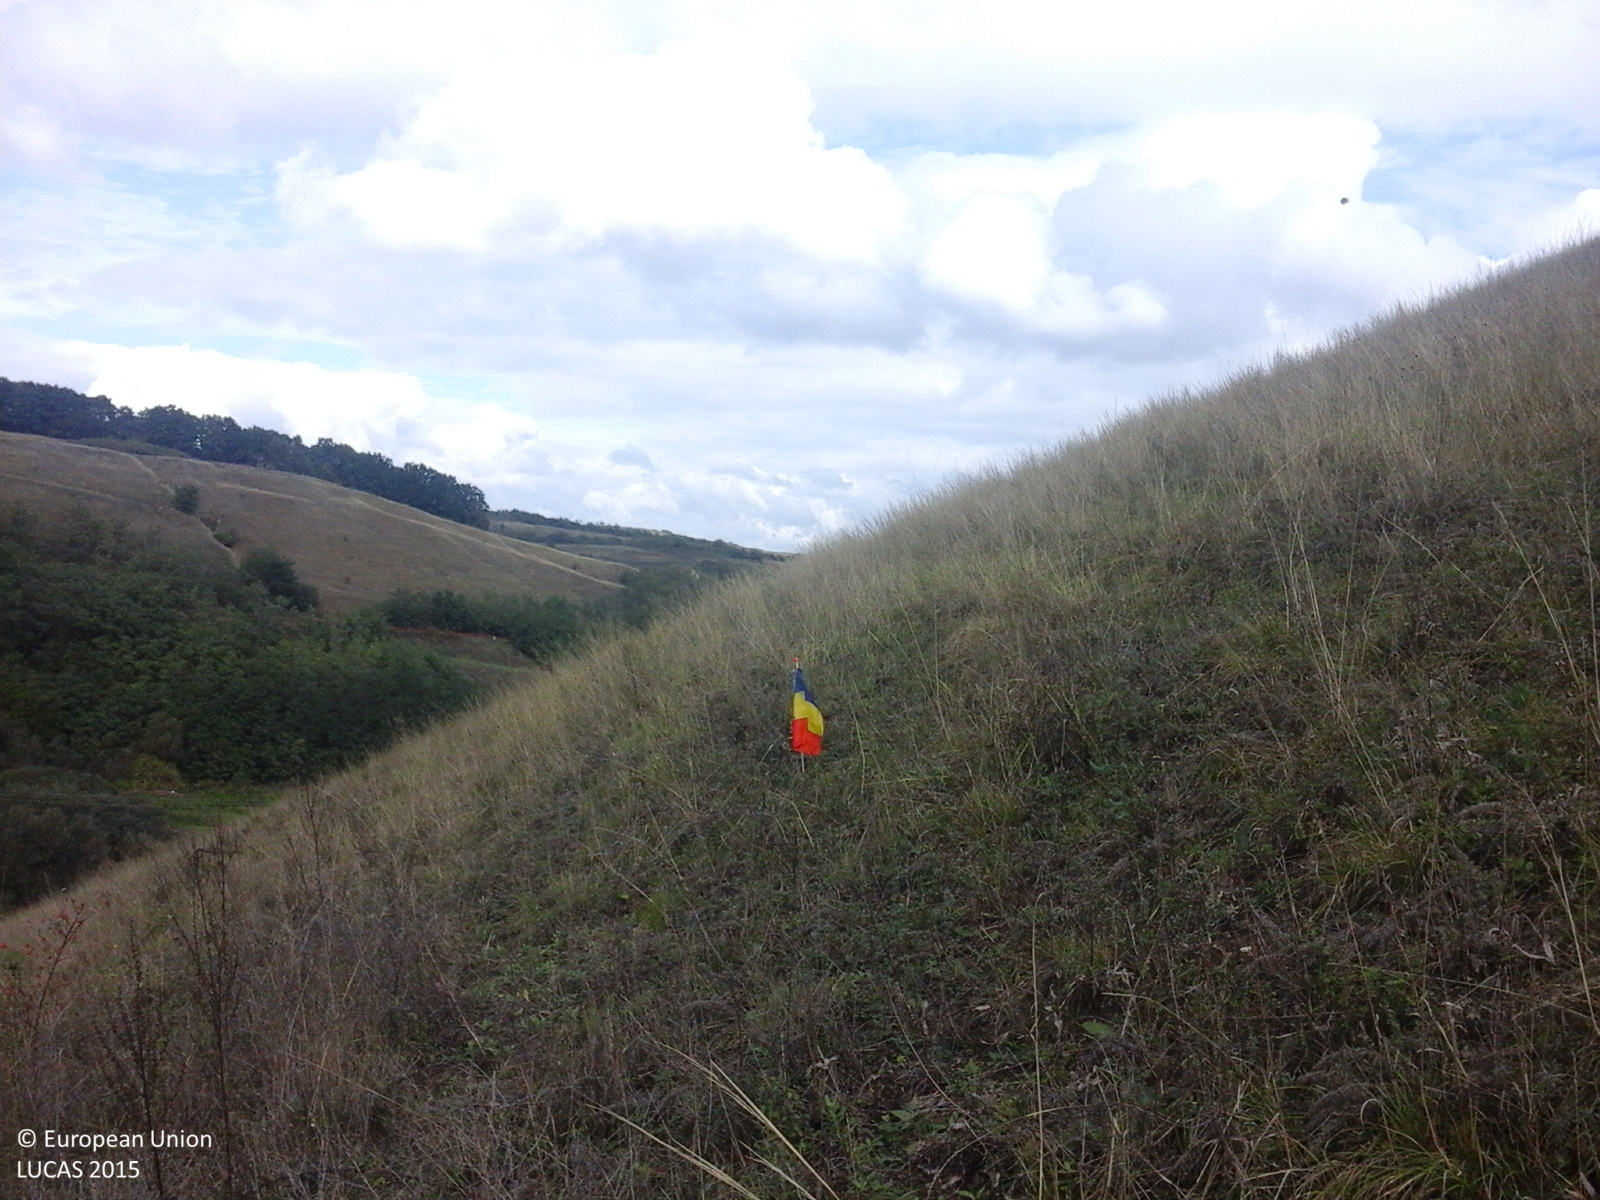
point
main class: Grassland
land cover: Grassland without tree/shrub cover
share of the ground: > 75 %
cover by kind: herbaceous plants 100 %
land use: Agriculture (excluding fallow land and kitchen gardens)
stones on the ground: < 10 %
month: September
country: RO
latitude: 46.0629
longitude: 23.7329
